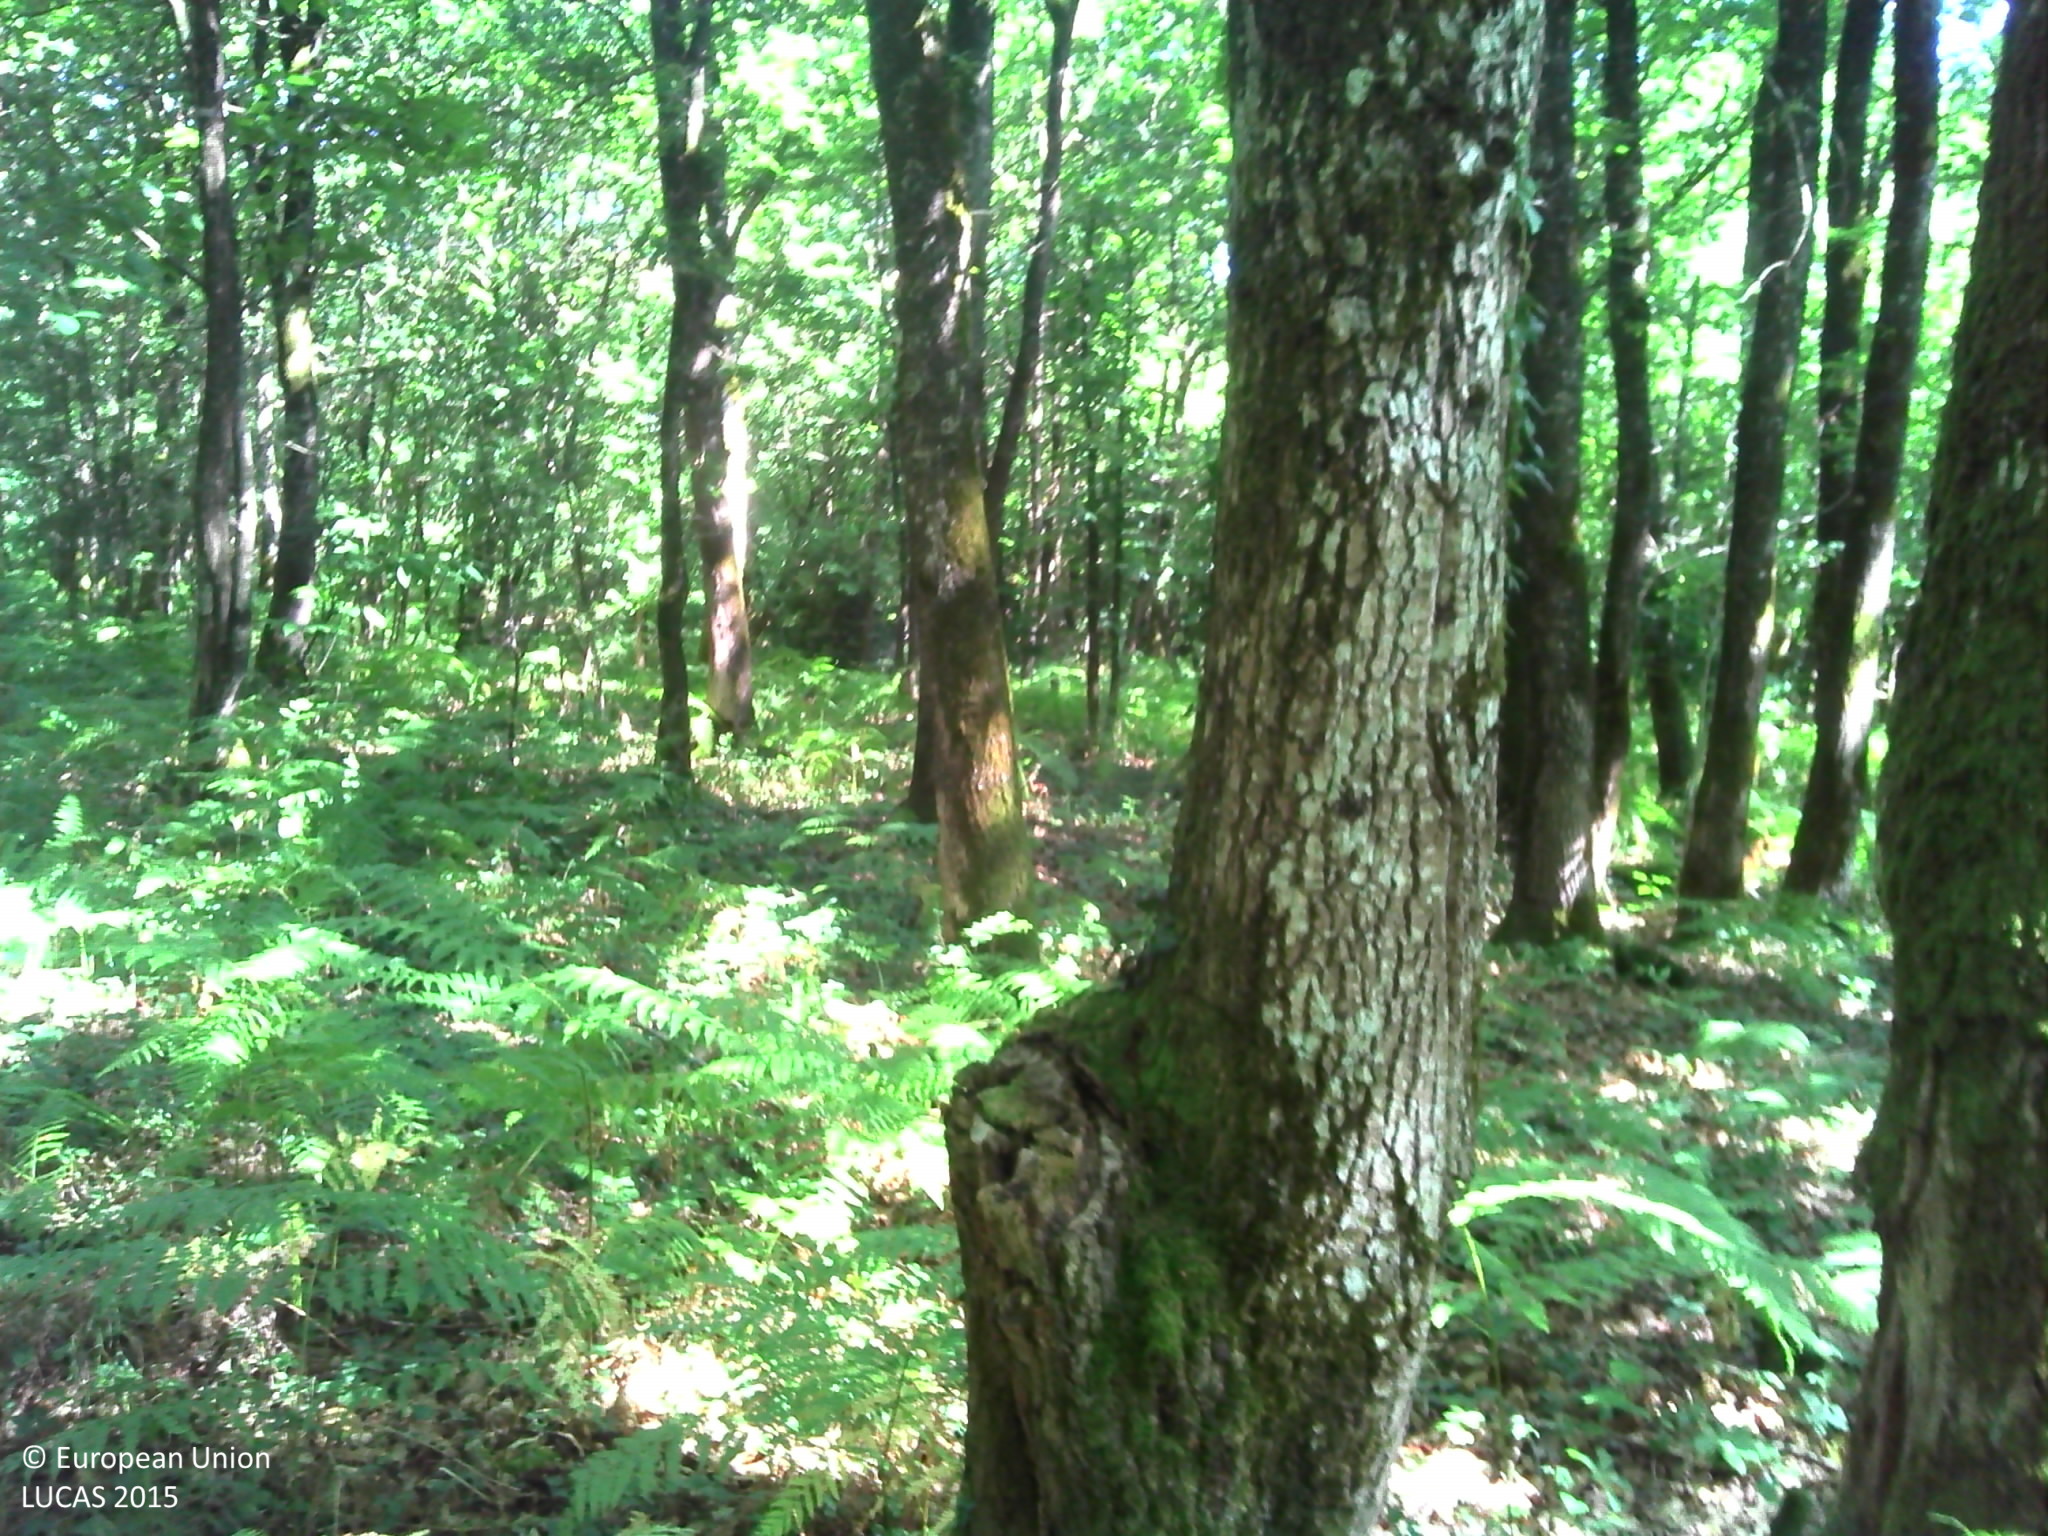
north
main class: Woodland
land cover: Broadleaved woodland
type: acidophilous oak and oak-birch forest
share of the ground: > 75 %
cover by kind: broadleaved forest trees 80 %, herbaceous plants 20 %
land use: Forestry
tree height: > 5 m
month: July
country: FR
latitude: 47.7633
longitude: -2.0188
